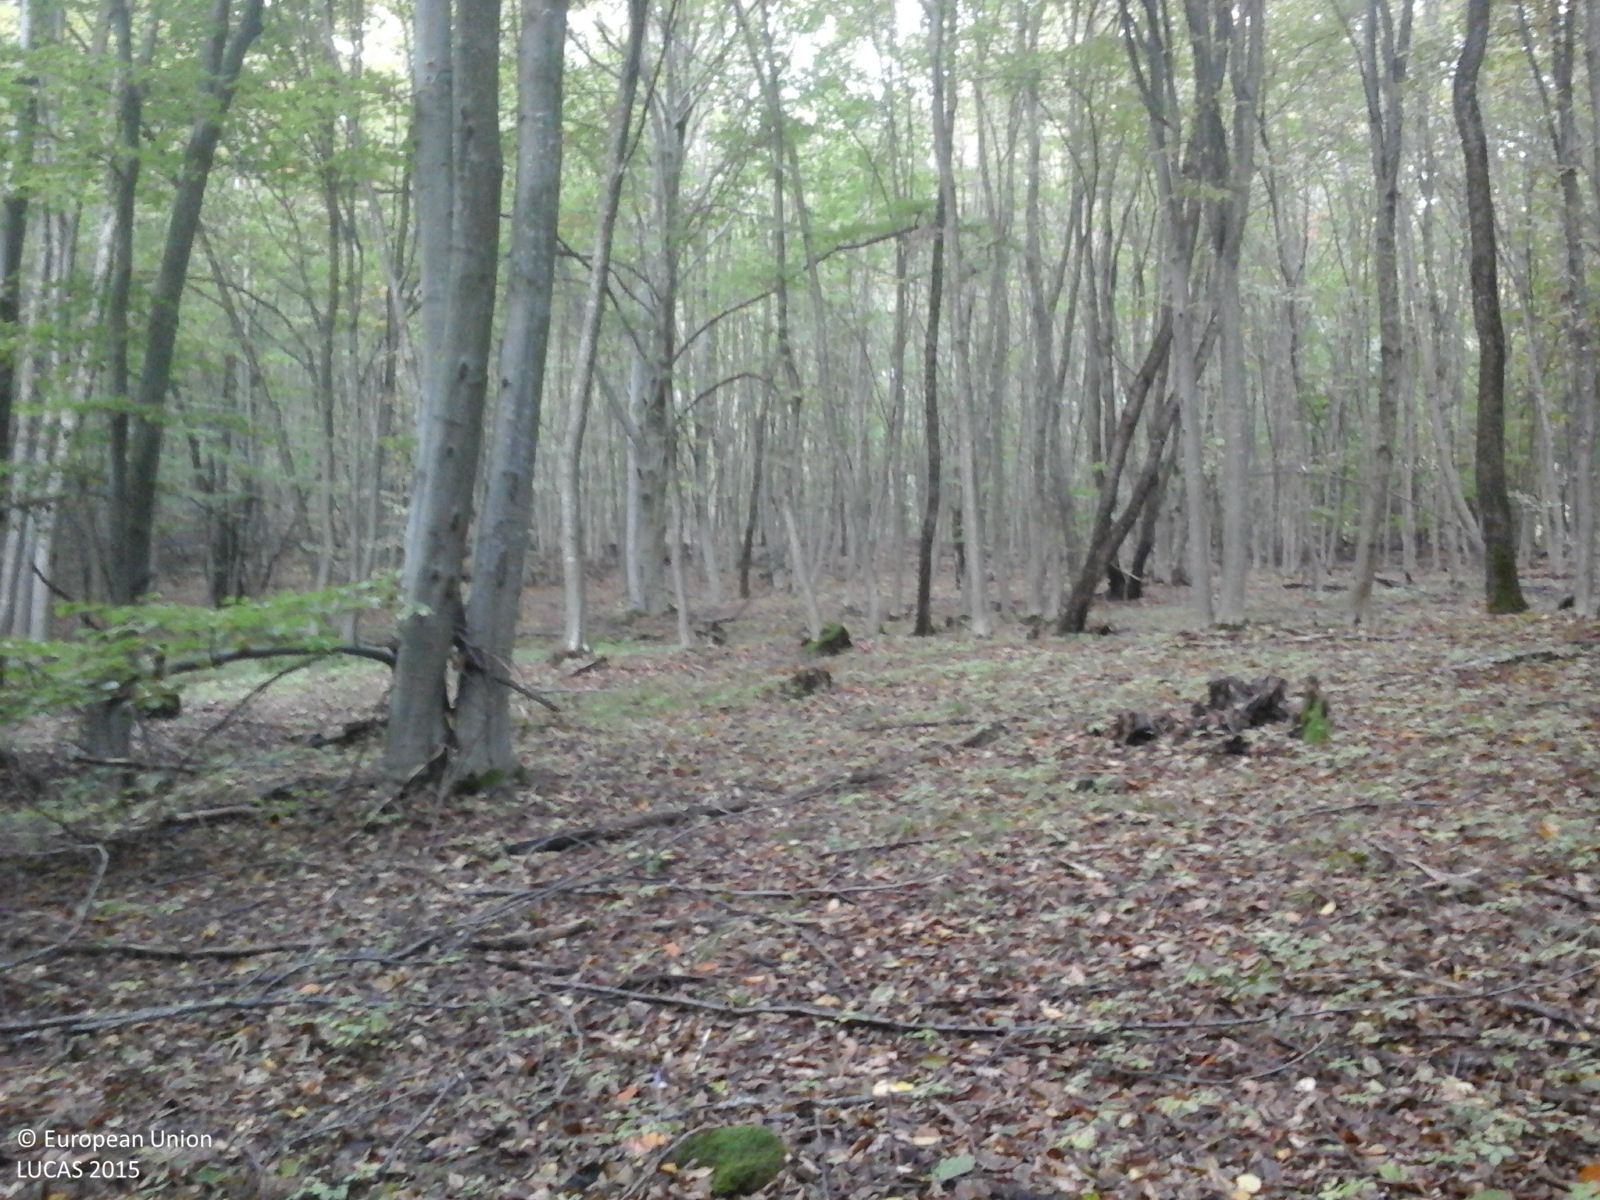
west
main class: Woodland
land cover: Broadleaved woodland
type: beech forest
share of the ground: > 75 %
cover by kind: broadleaved forest trees 100 %
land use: Forestry
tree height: > 5 m
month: October
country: RO
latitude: 45.8964
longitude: 25.0840
